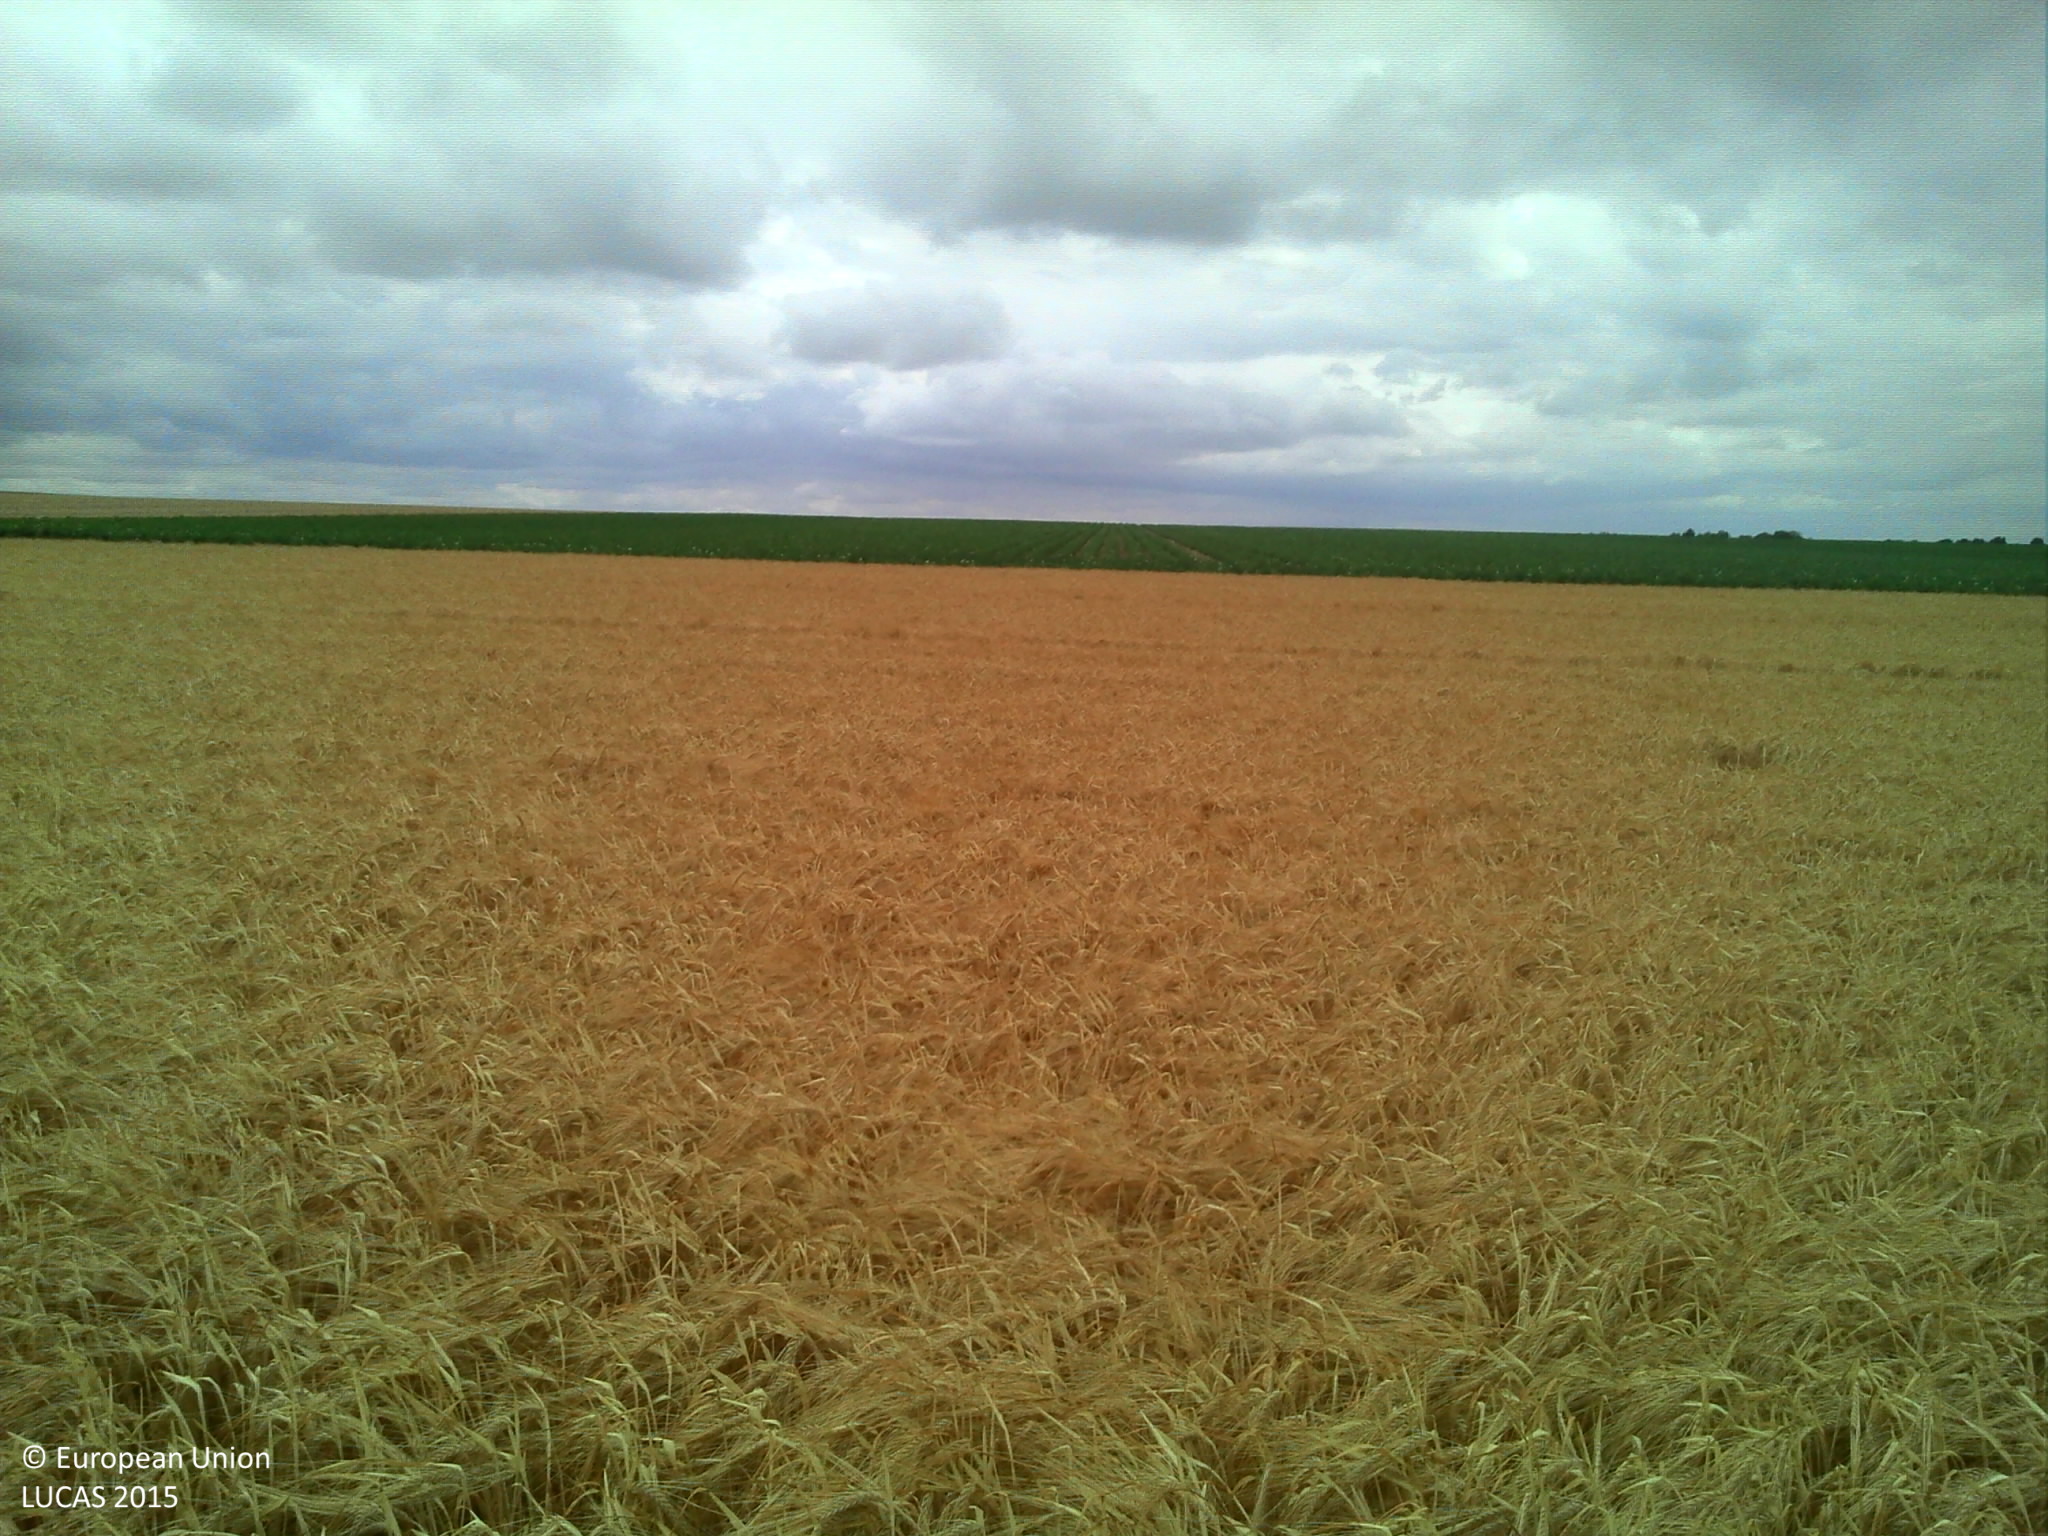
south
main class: Cropland
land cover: Barley
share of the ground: > 75 %
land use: Agriculture (excluding fallow land and kitchen gardens)
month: July
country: FR
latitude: 48.7571
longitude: 4.2149
